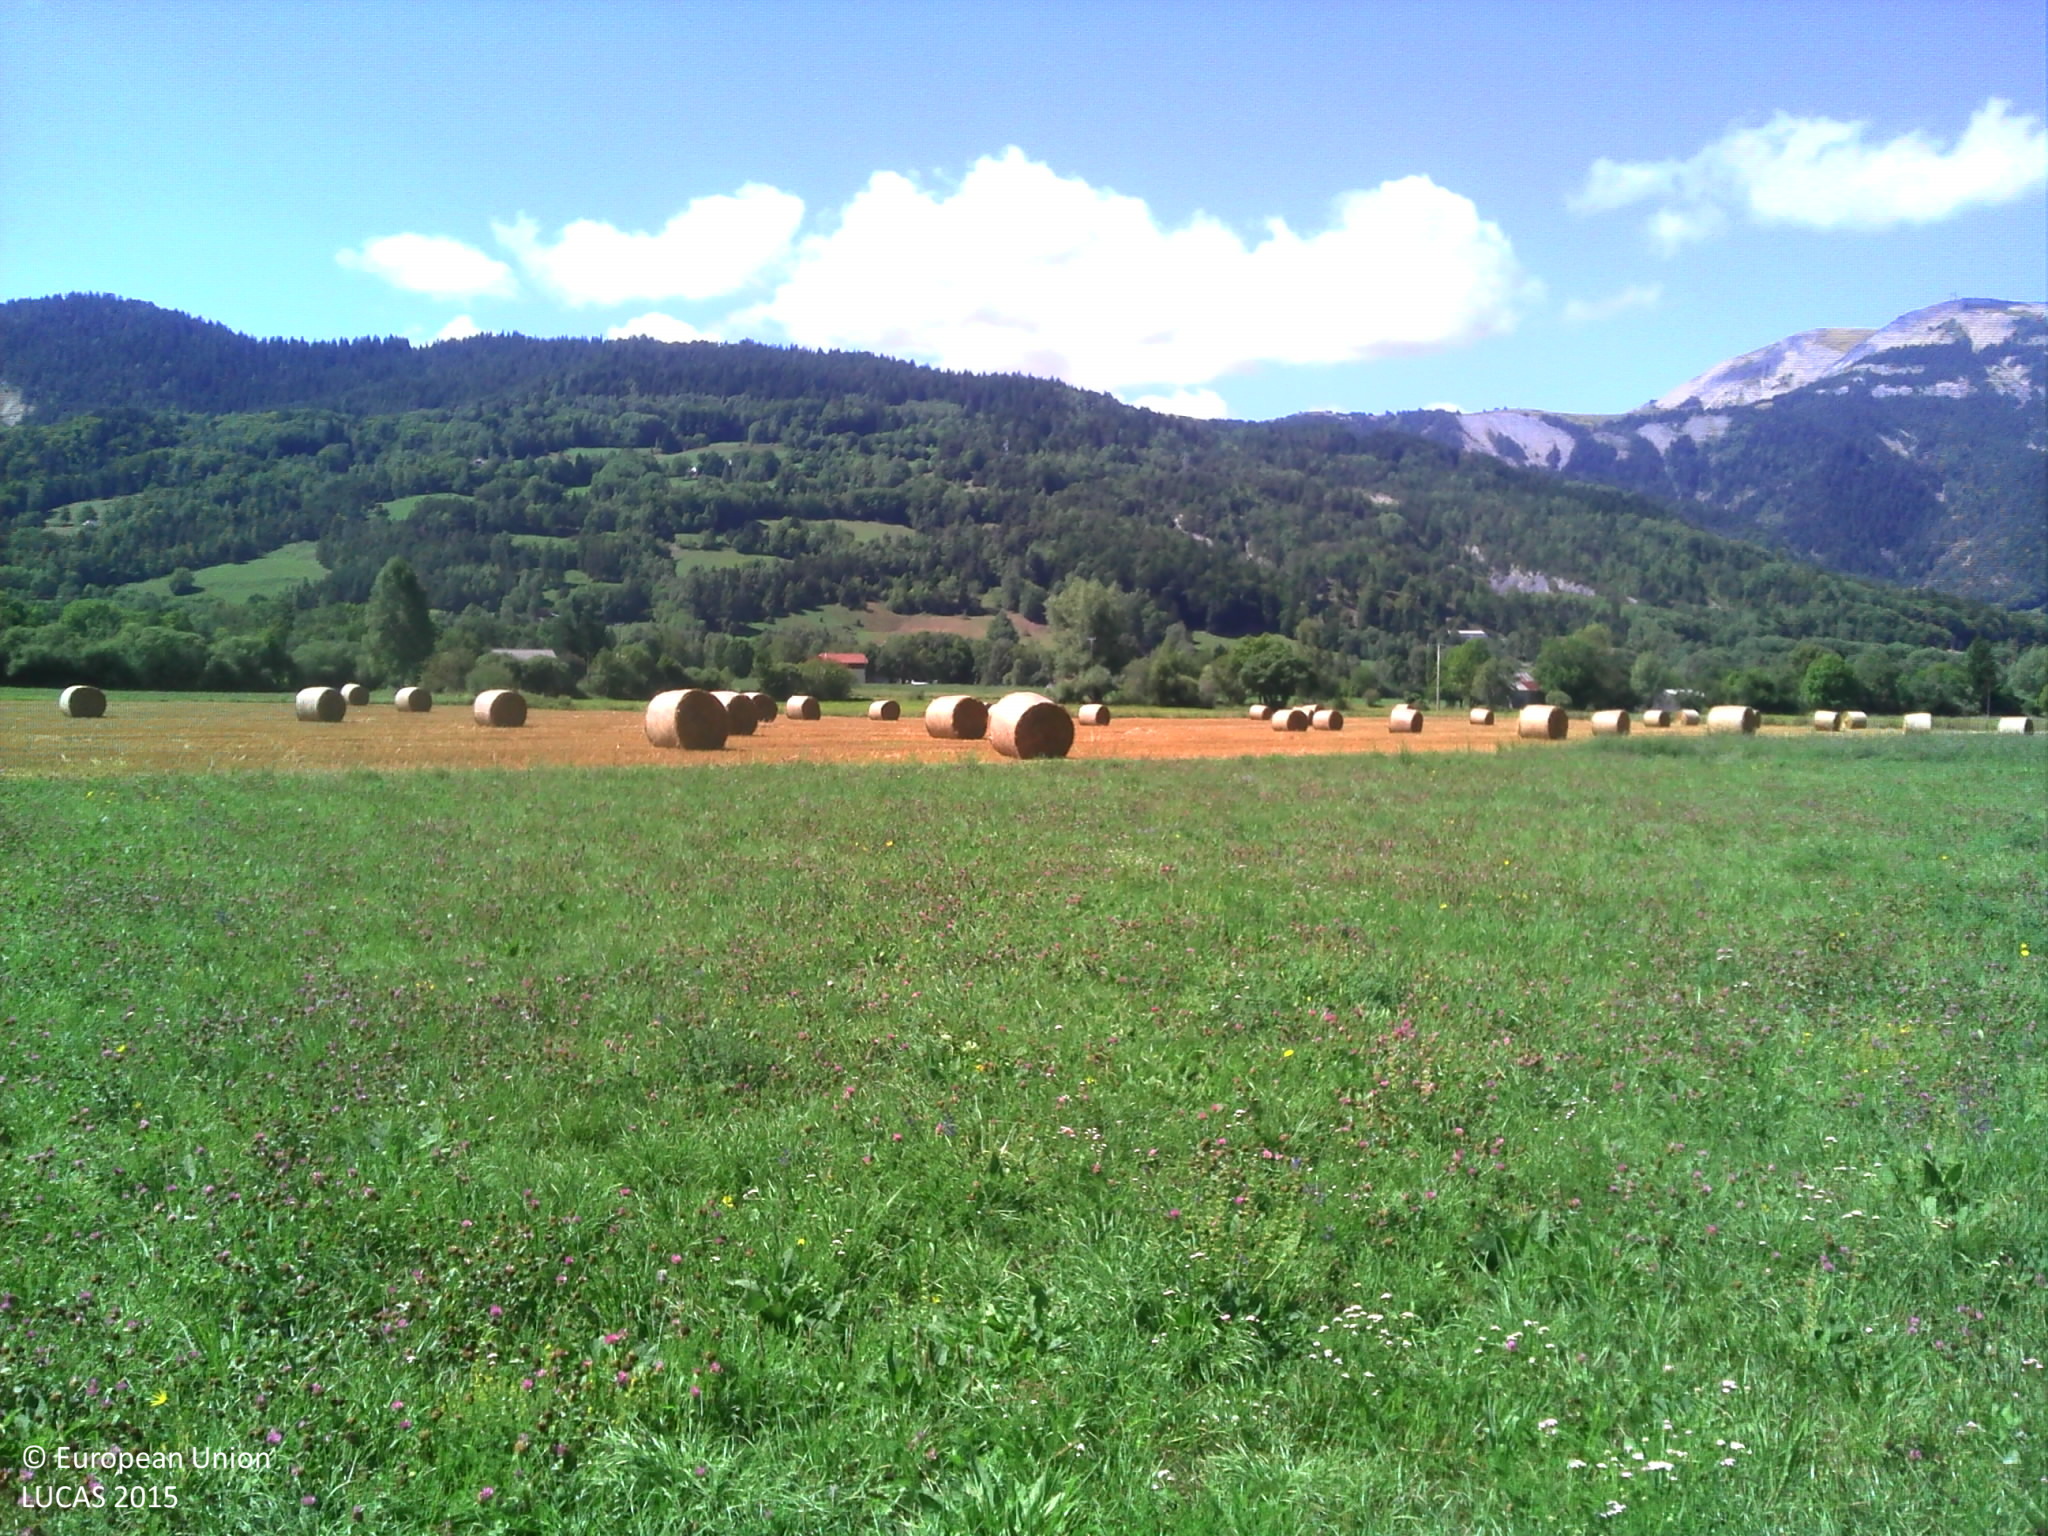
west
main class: Grassland
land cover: Grassland without tree/shrub cover
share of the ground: > 75 %
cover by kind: herbaceous plants 100 %
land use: Agriculture (excluding fallow land and kitchen gardens)
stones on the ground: < 10 %
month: August
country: FR
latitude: 44.3408
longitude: 6.3569
